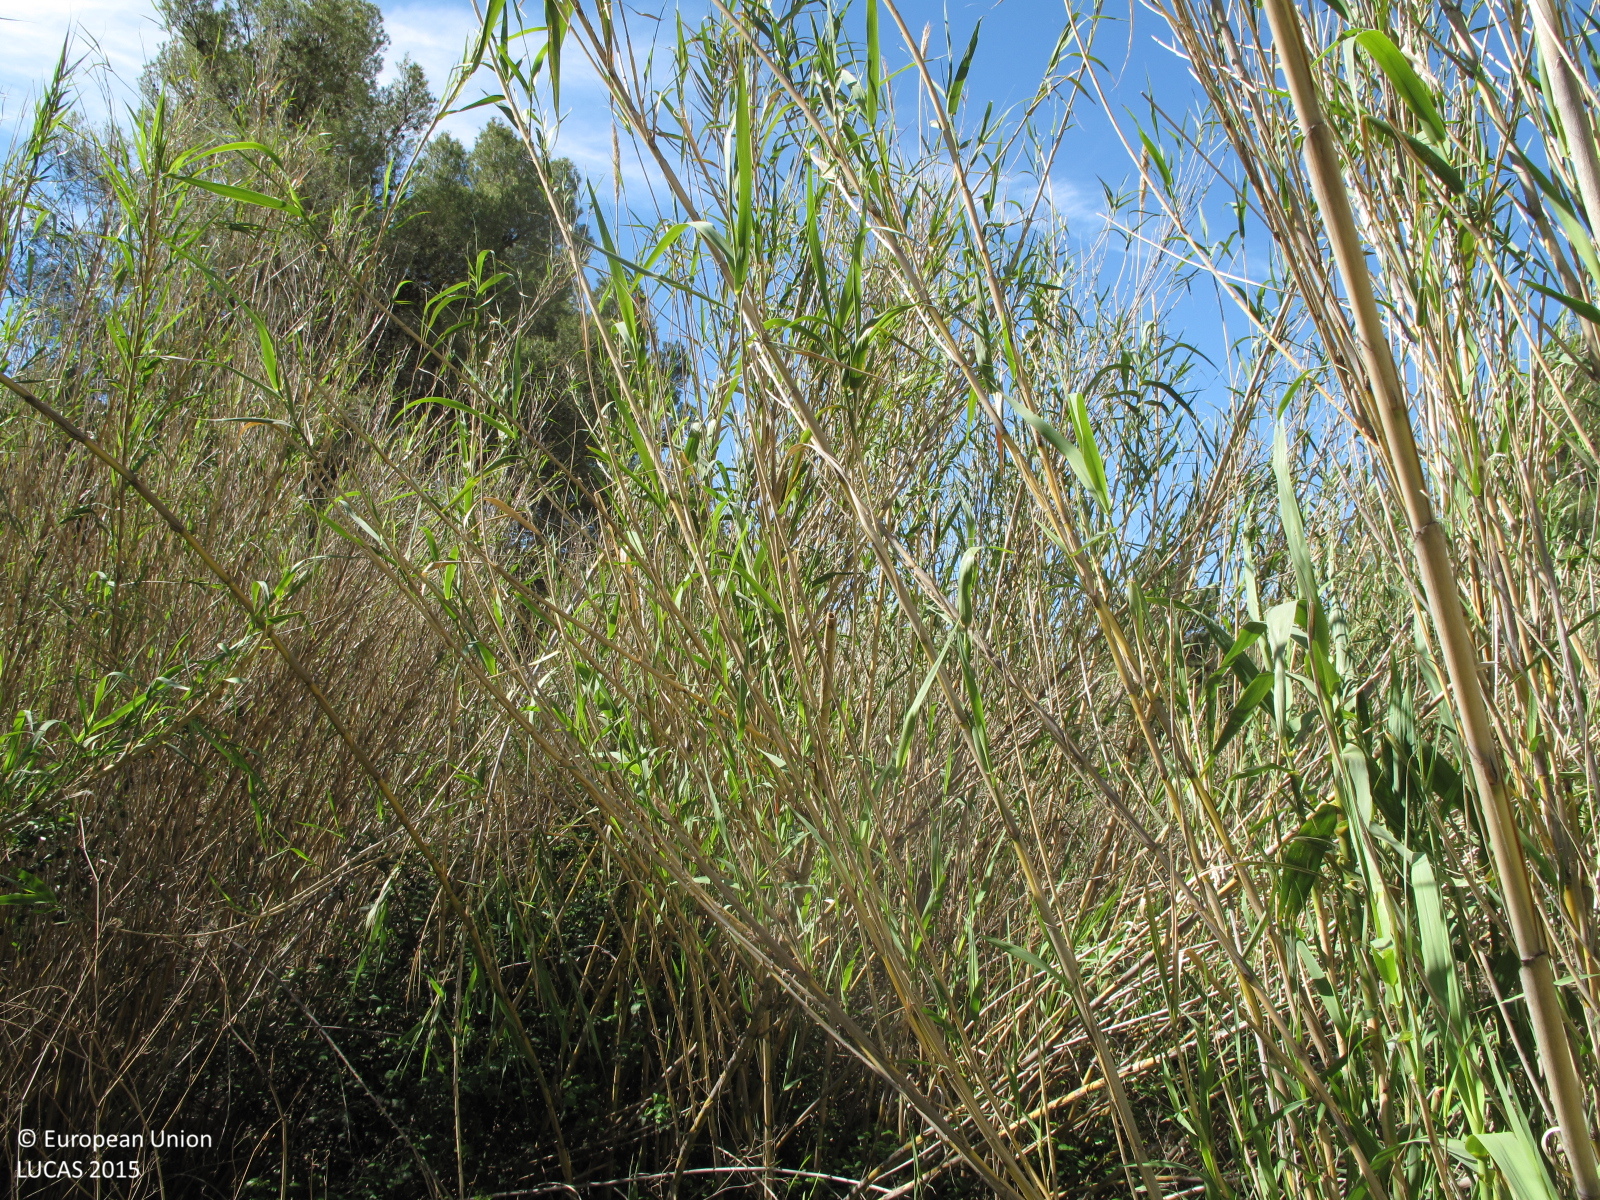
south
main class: Shrubland
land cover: Shrubland without tree cover
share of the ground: > 75 %
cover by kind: shrubs 90 %, herbaceous plants 10 %
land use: Semi-natural and natural areas not in use
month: April
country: ES
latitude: 38.5772
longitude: -0.4449
